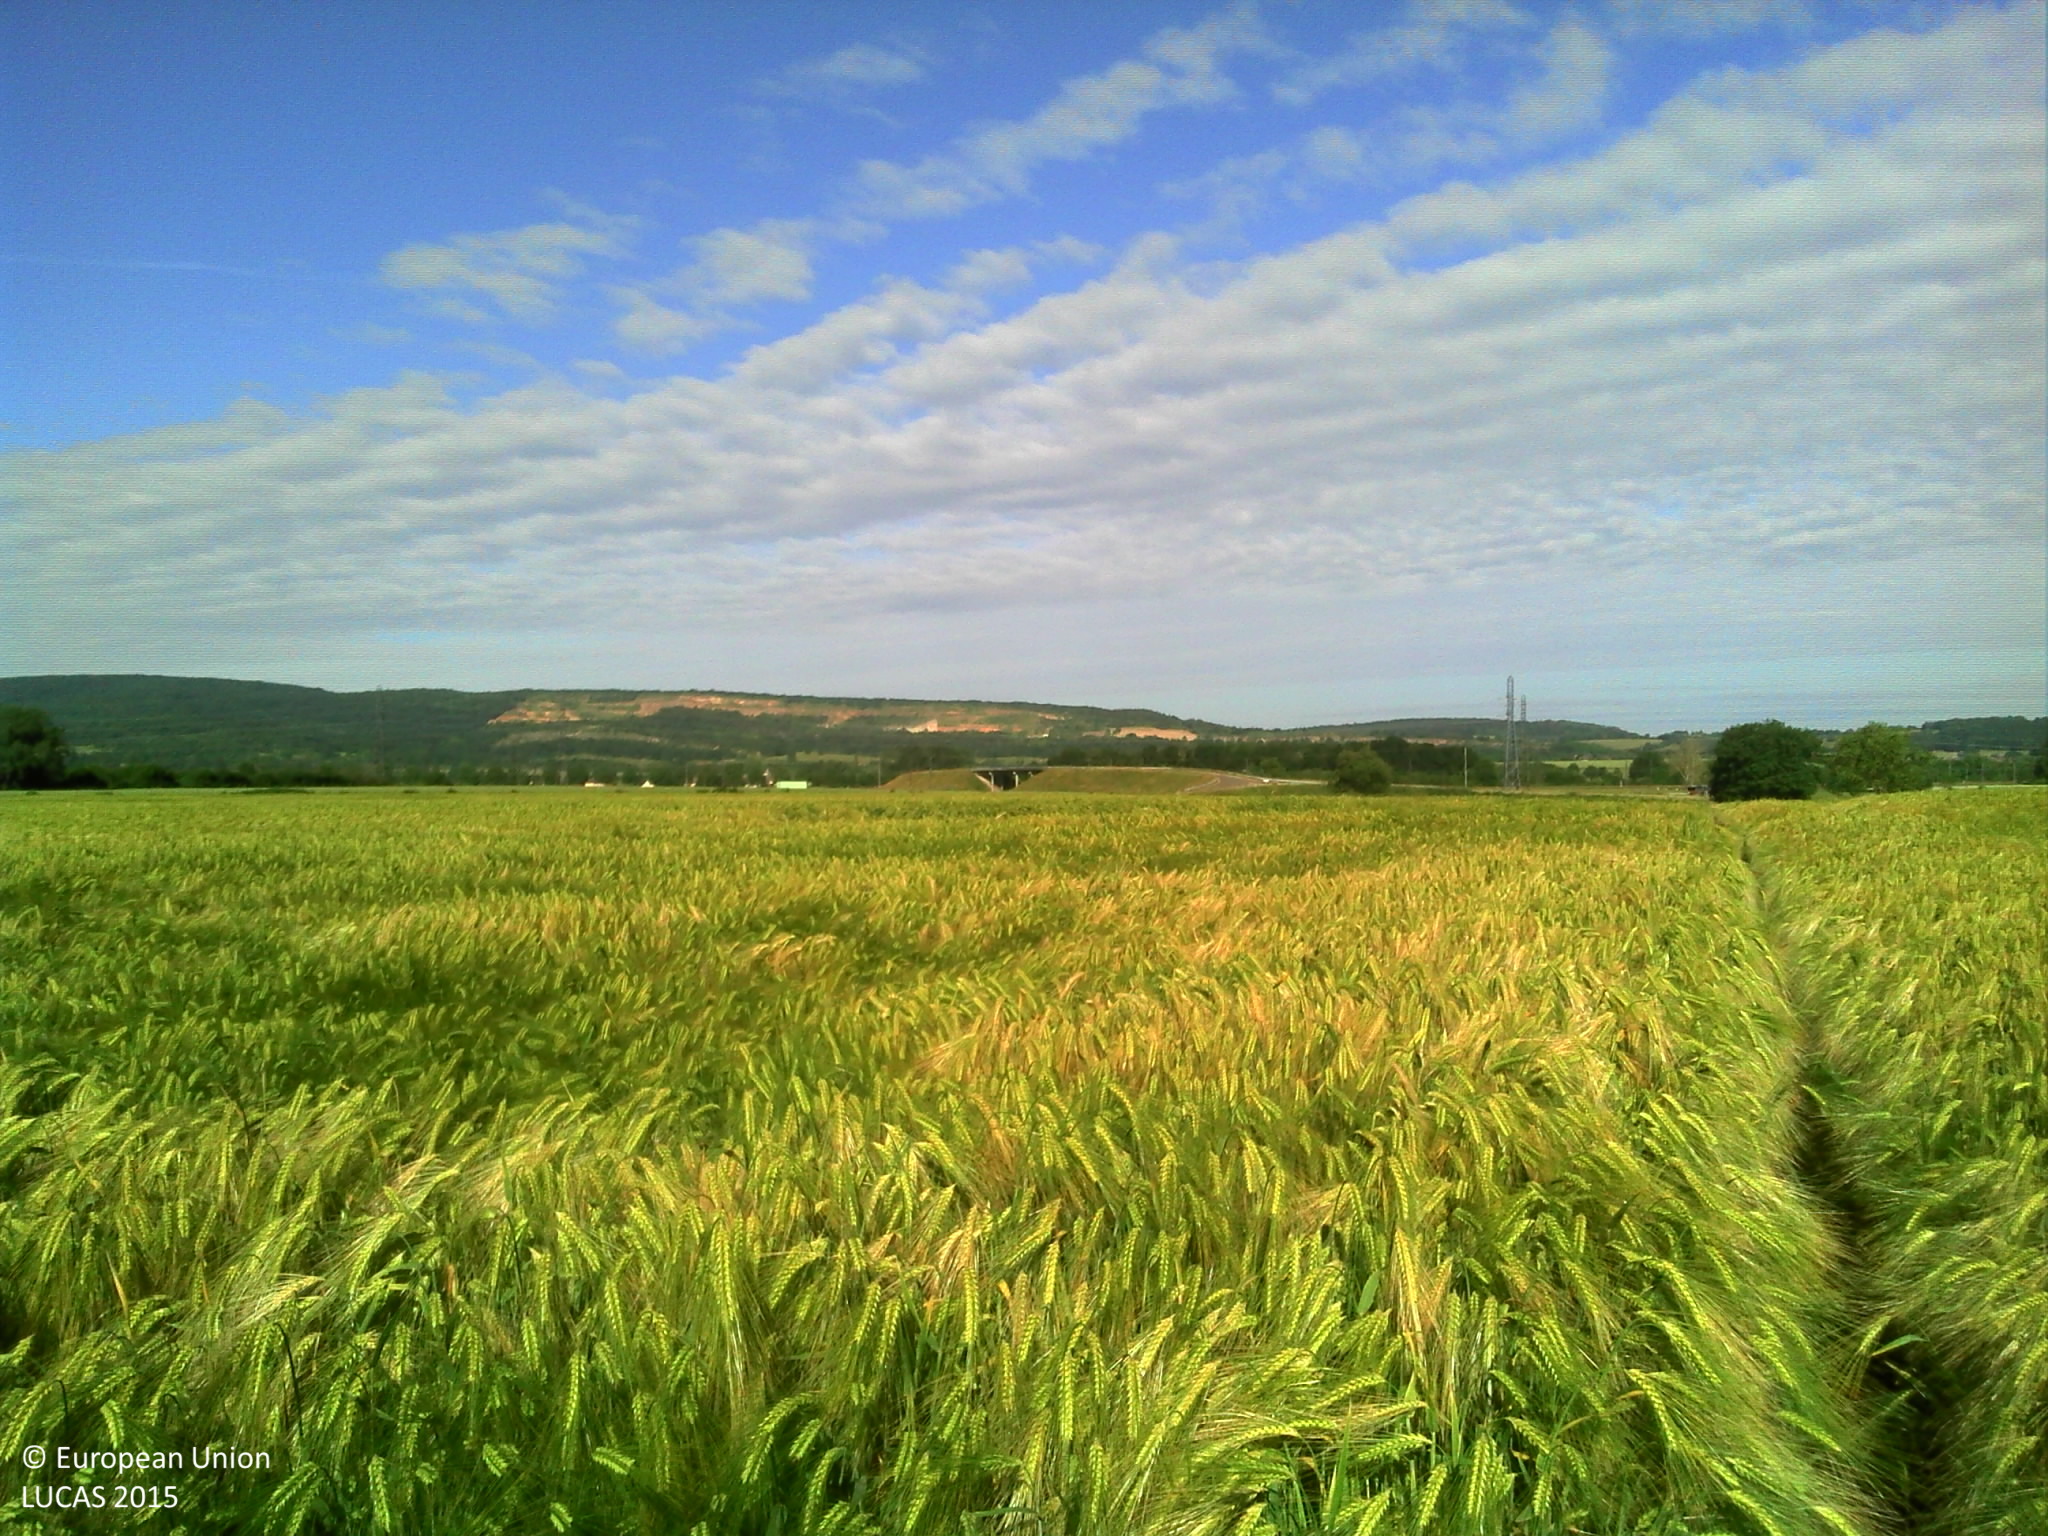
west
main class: Cropland
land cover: Barley
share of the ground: > 75 %
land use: Agriculture (excluding fallow land and kitchen gardens)
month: June
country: FR
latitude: 46.6263
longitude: 4.8950
